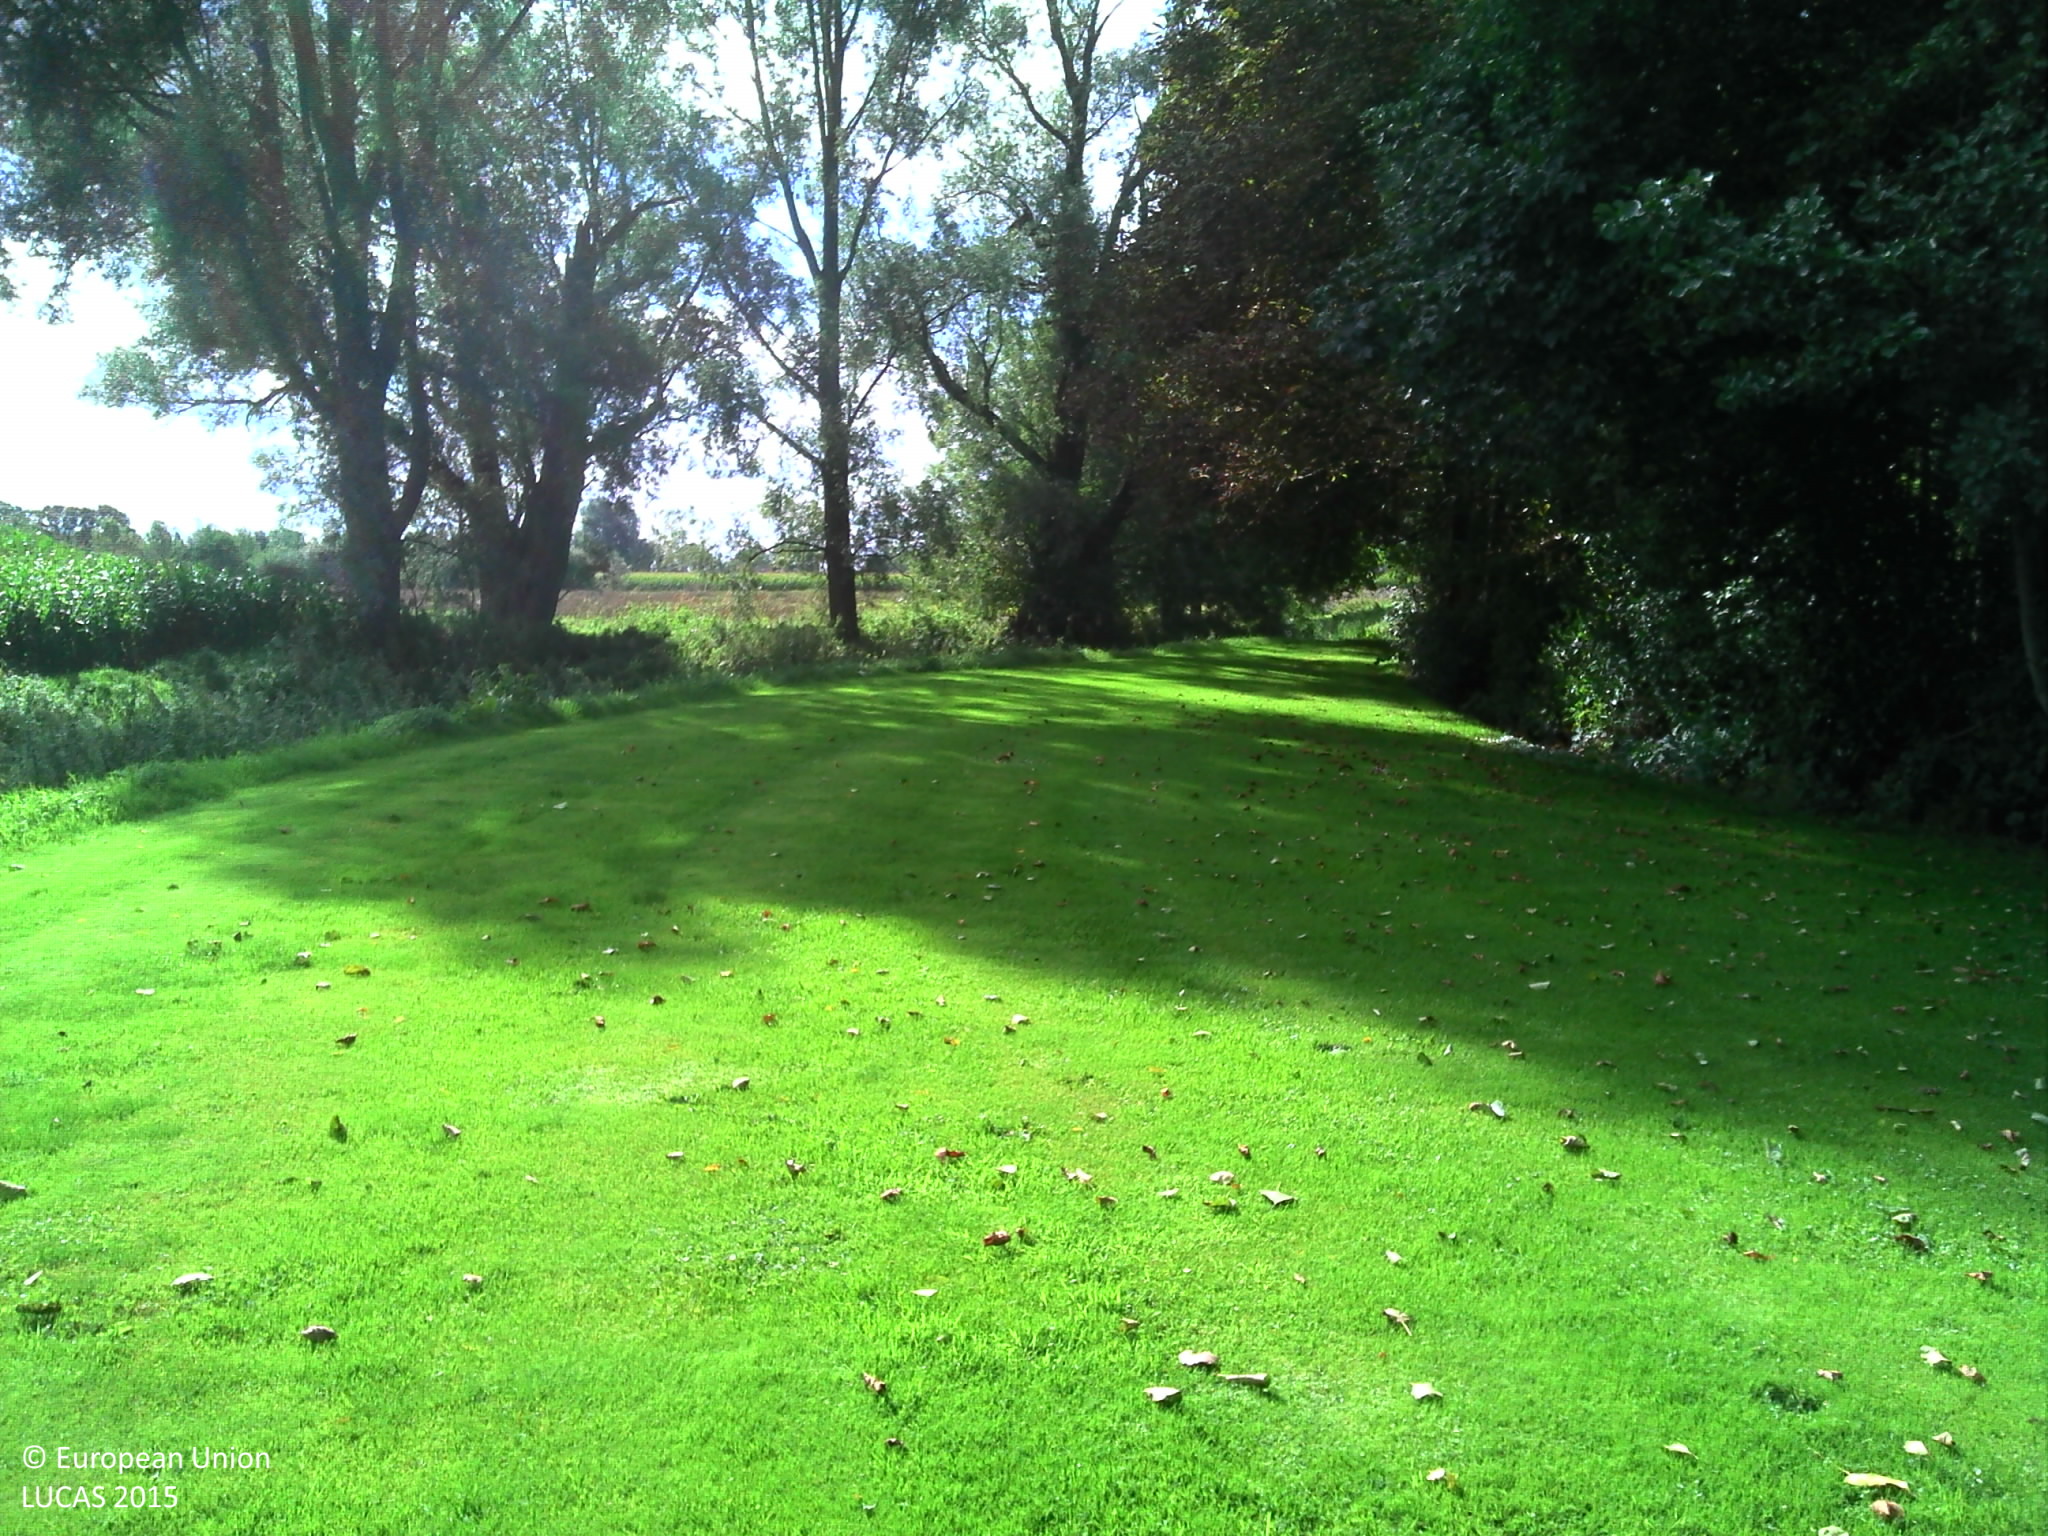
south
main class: Grassland
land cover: Grassland without tree/shrub cover
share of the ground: > 75 %
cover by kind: herbaceous plants 100 %
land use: Residential
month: September
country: BE
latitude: 51.4744
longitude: 4.4815
